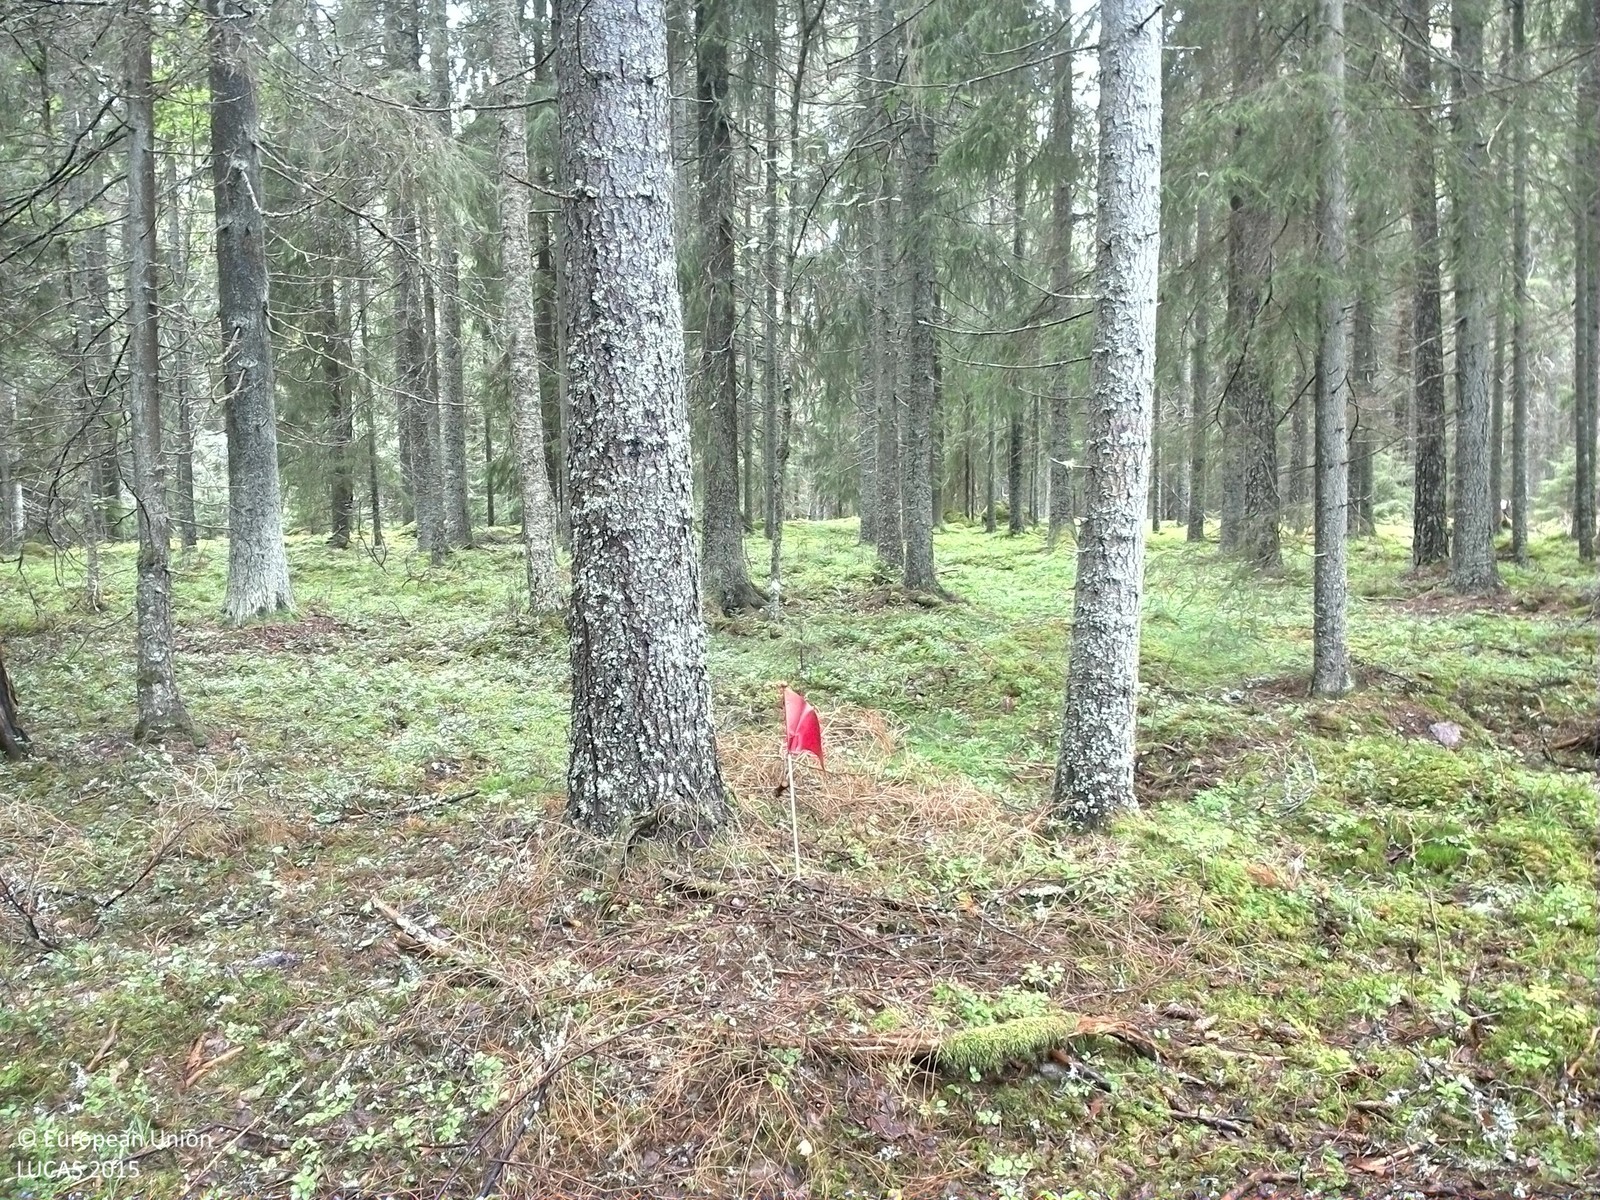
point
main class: Woodland
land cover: Spruce dominated coniferous woodland
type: boreal forest
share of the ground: 50 - 75 %
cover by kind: coniferous forest trees 65 %, shrubs 15 %, lichens and mosses 15 %, broadleaved forest trees 5 %
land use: Forestry
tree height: > 5 m
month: September
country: SE
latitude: 59.2846
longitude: 11.9785
